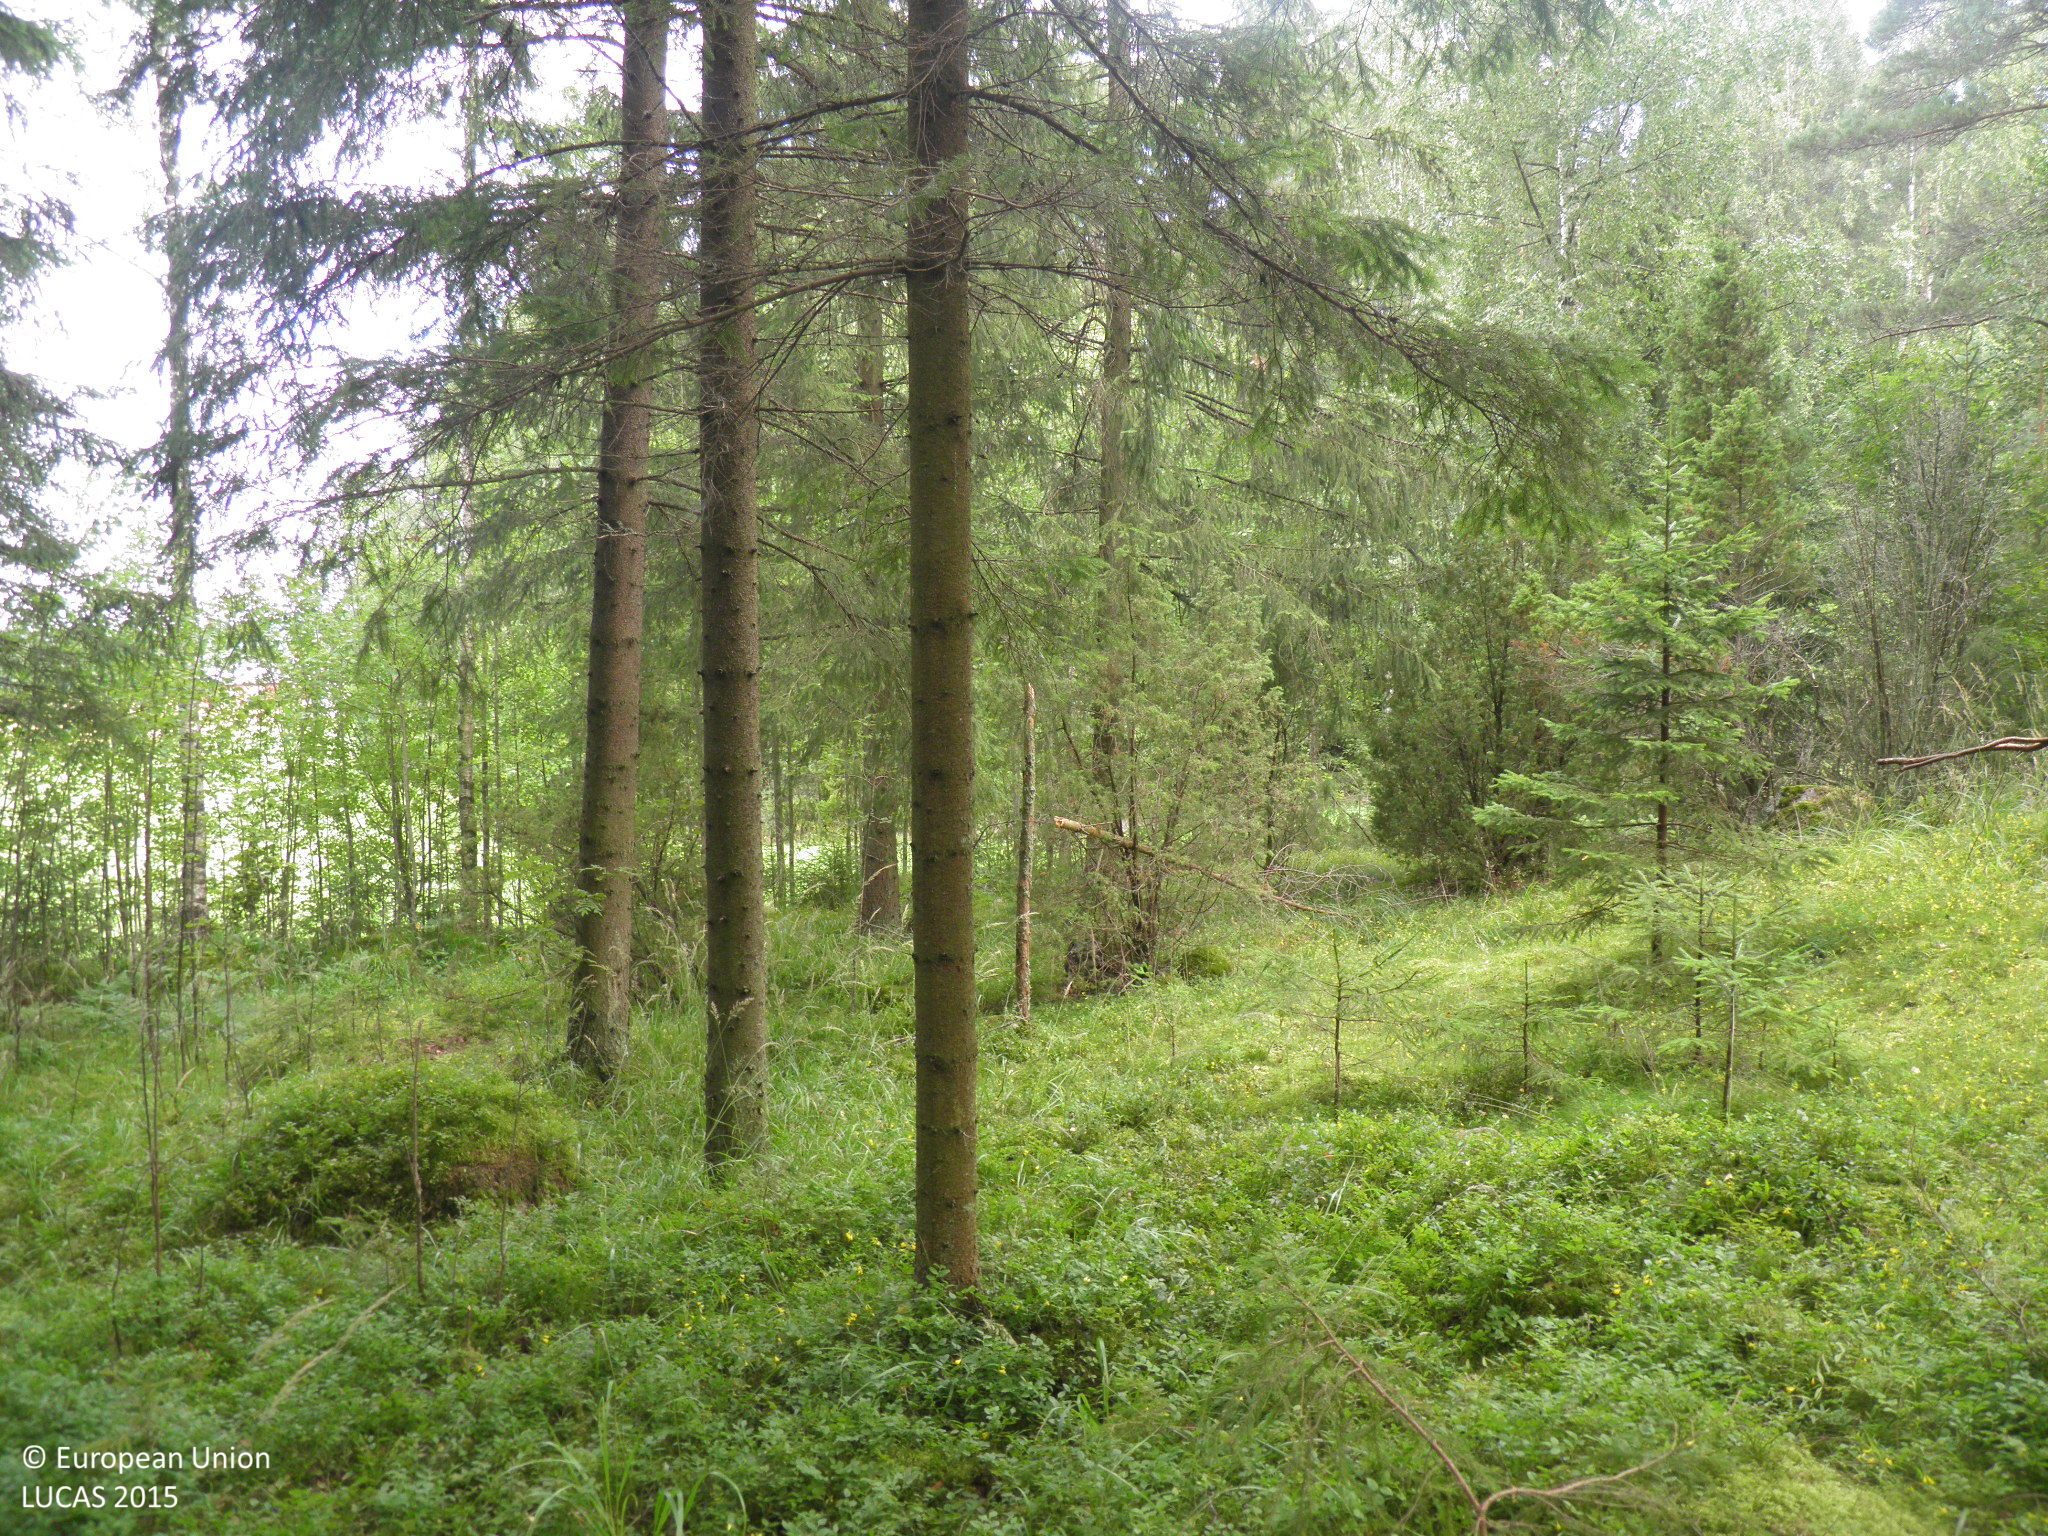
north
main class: Woodland
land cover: Spruce dominated coniferous woodland
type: hemiboreal forest and nemoral coniferous forest and mixed broadleaved-coniferous forest
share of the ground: > 75 %
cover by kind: coniferous forest trees 70 %, shrubs 10 %, herbaceous plants 10 %, broadleaved forest trees 5 %, lichens and mosses 5 %
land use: Forestry
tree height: > 5 m
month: August
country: FI
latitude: 60.8498
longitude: 22.4532
